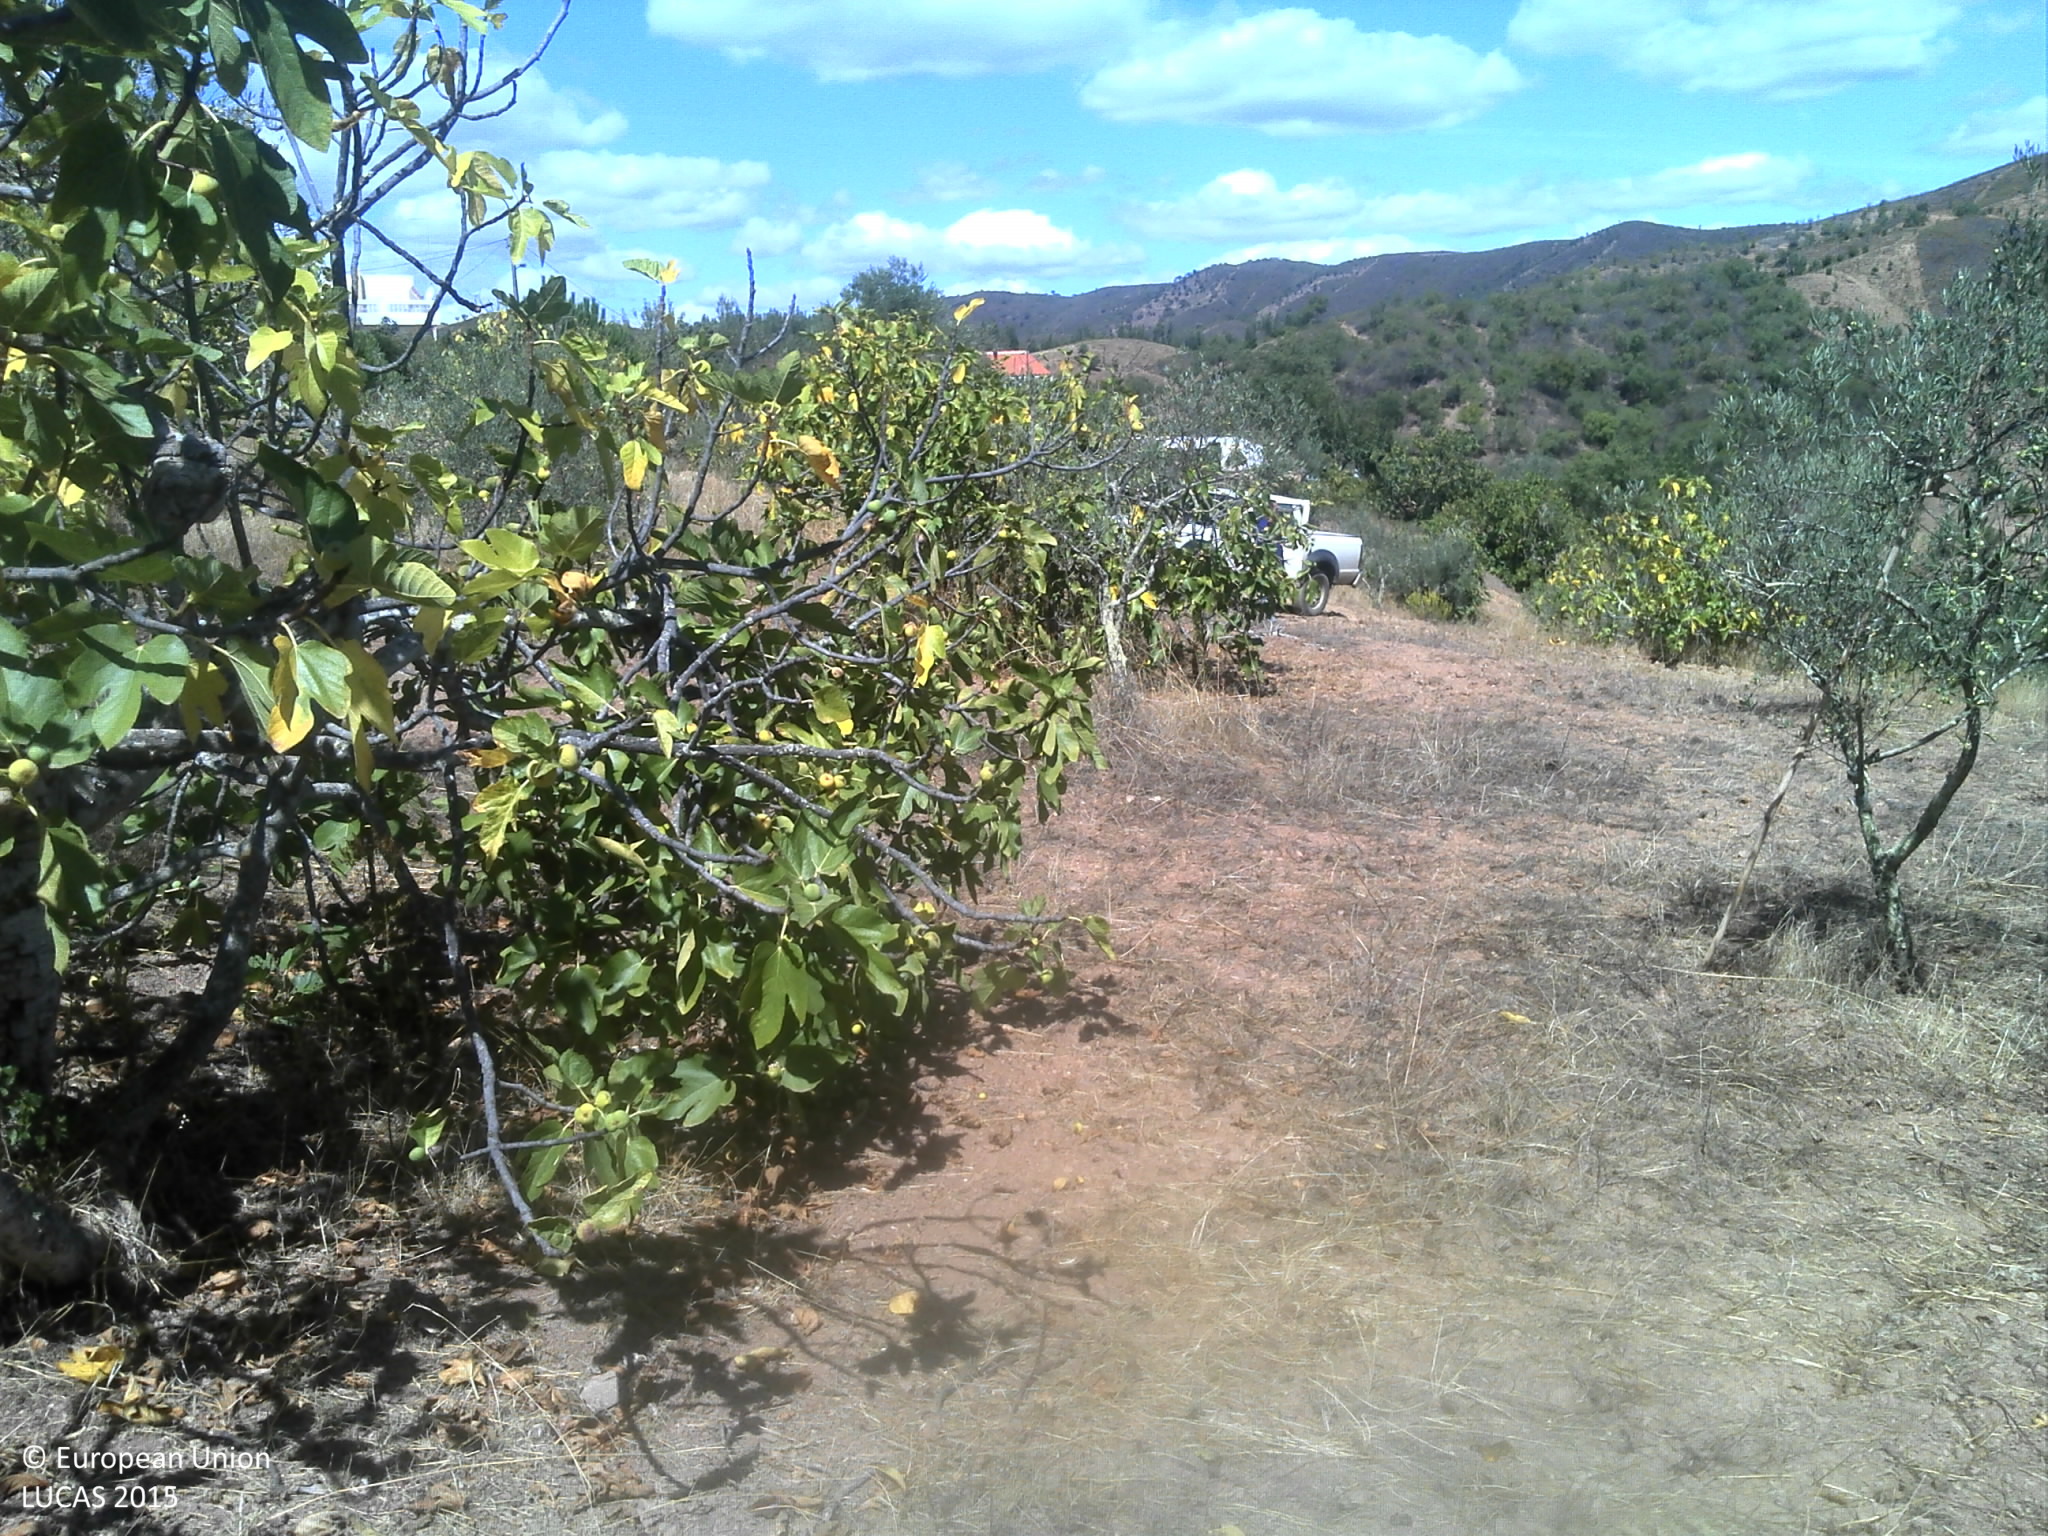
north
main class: Cropland
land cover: Pear fruit
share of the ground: 25 - 50 %
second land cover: Grassland without tree/shrub cover
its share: 25 - 50 %
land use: Agriculture (excluding fallow land and kitchen gardens)
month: September
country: PT
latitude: 37.3136
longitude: -8.1758
